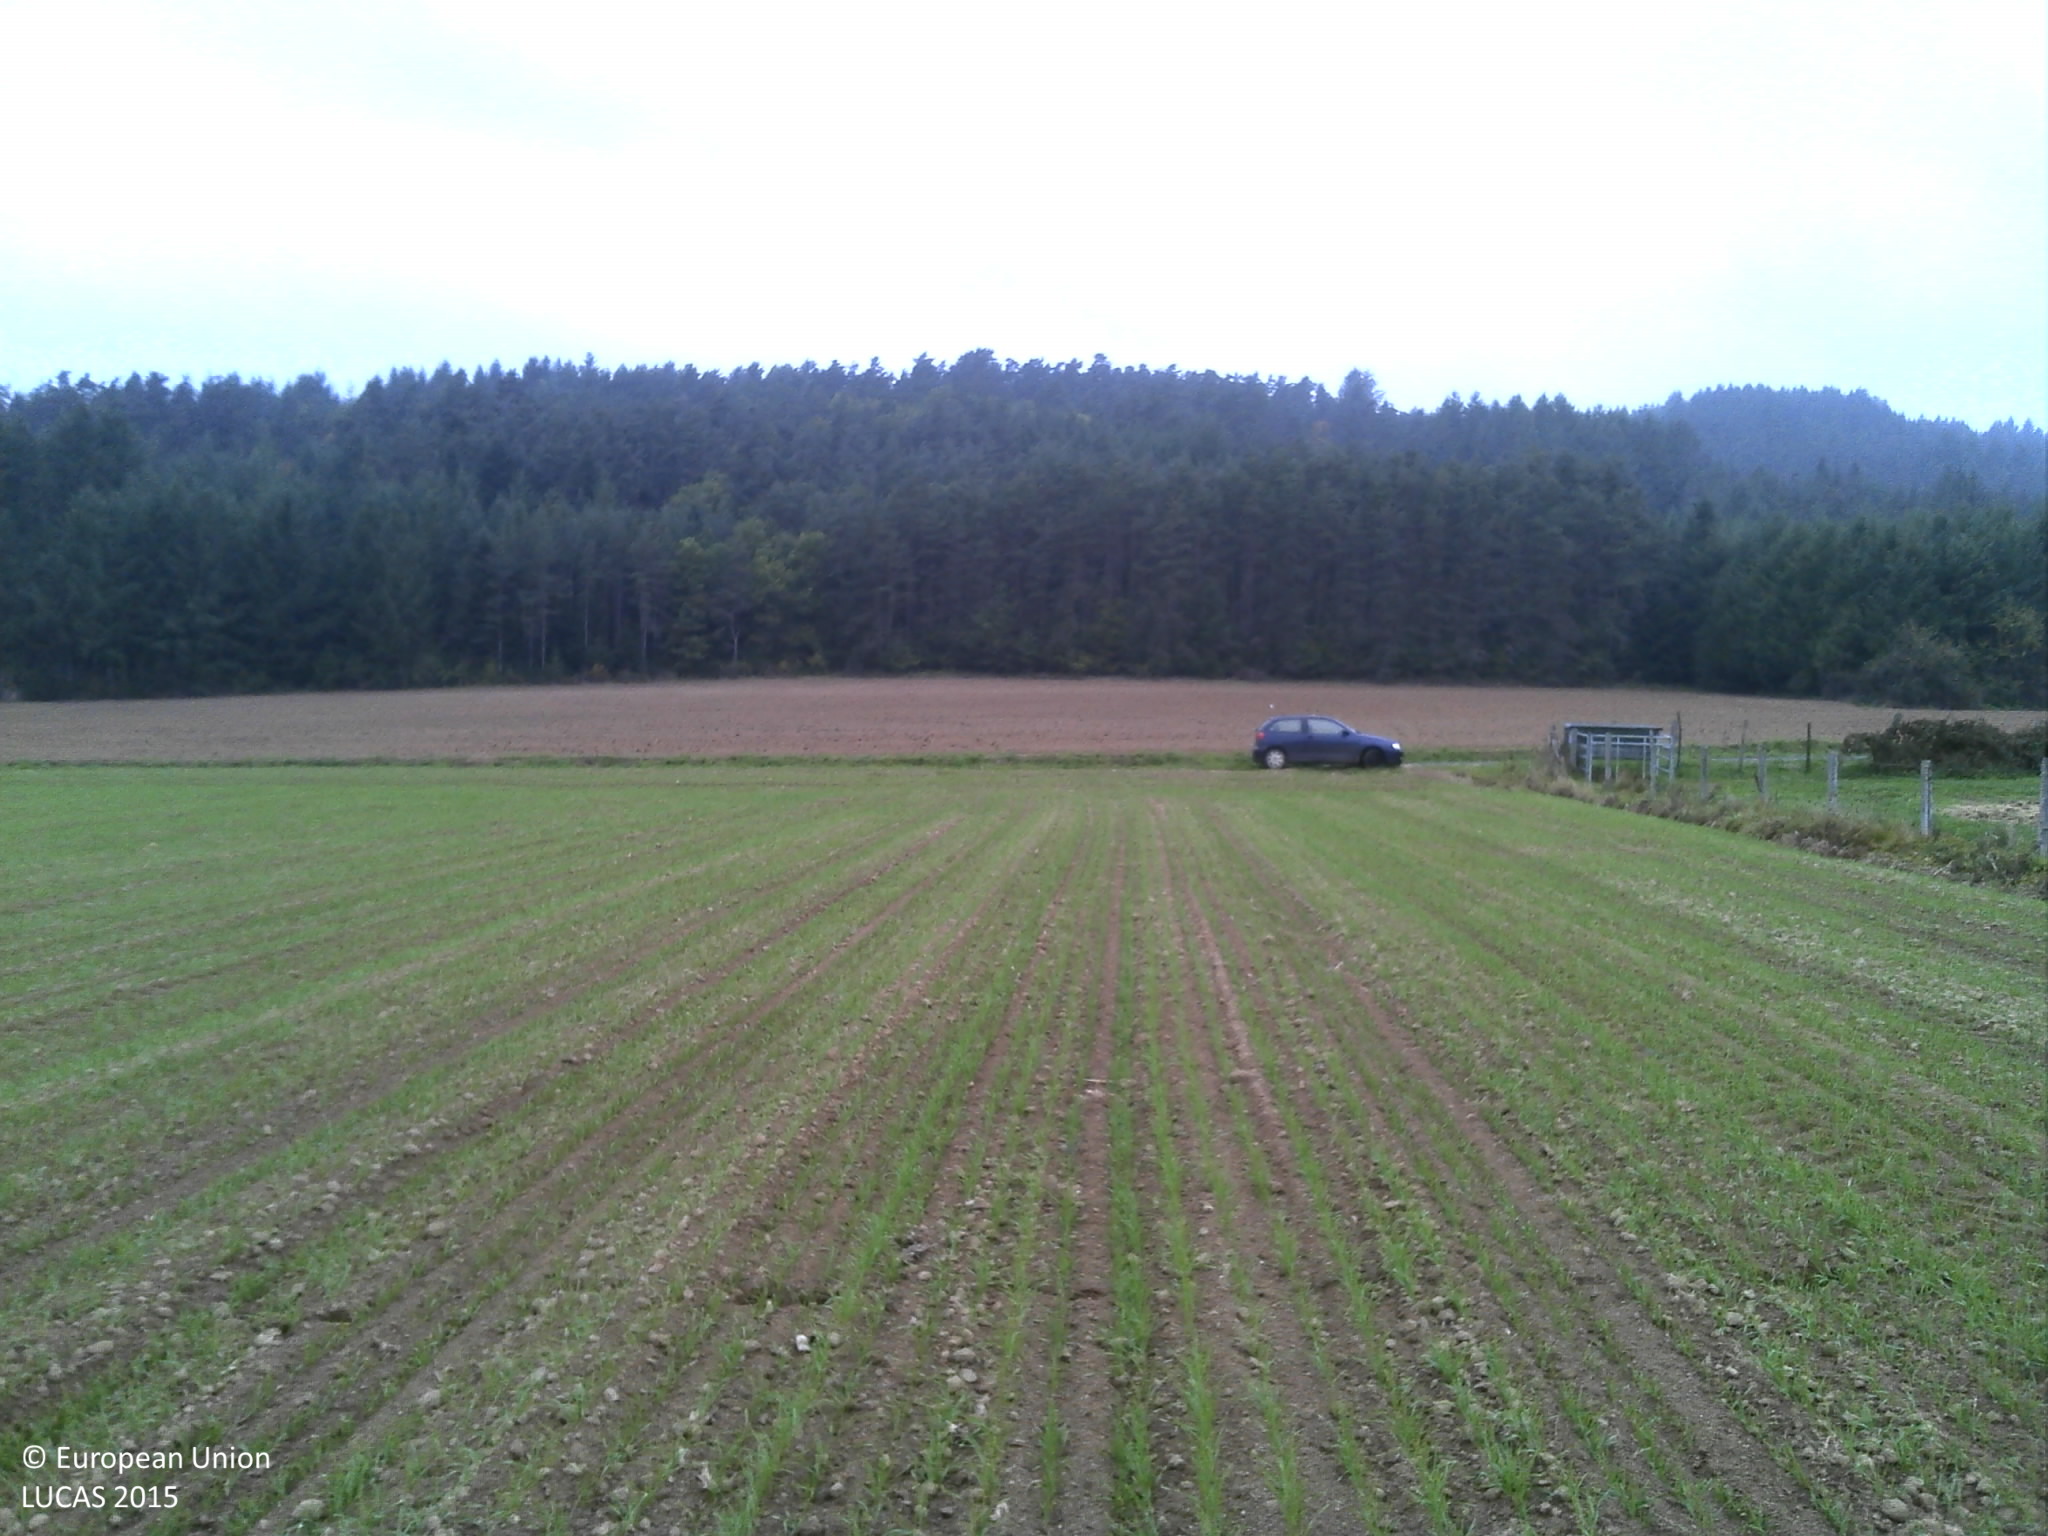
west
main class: Cropland
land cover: Common wheat
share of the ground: 25 - 50 %
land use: Agriculture (excluding fallow land and kitchen gardens)
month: October
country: FR
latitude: 45.4981
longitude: 3.7189
